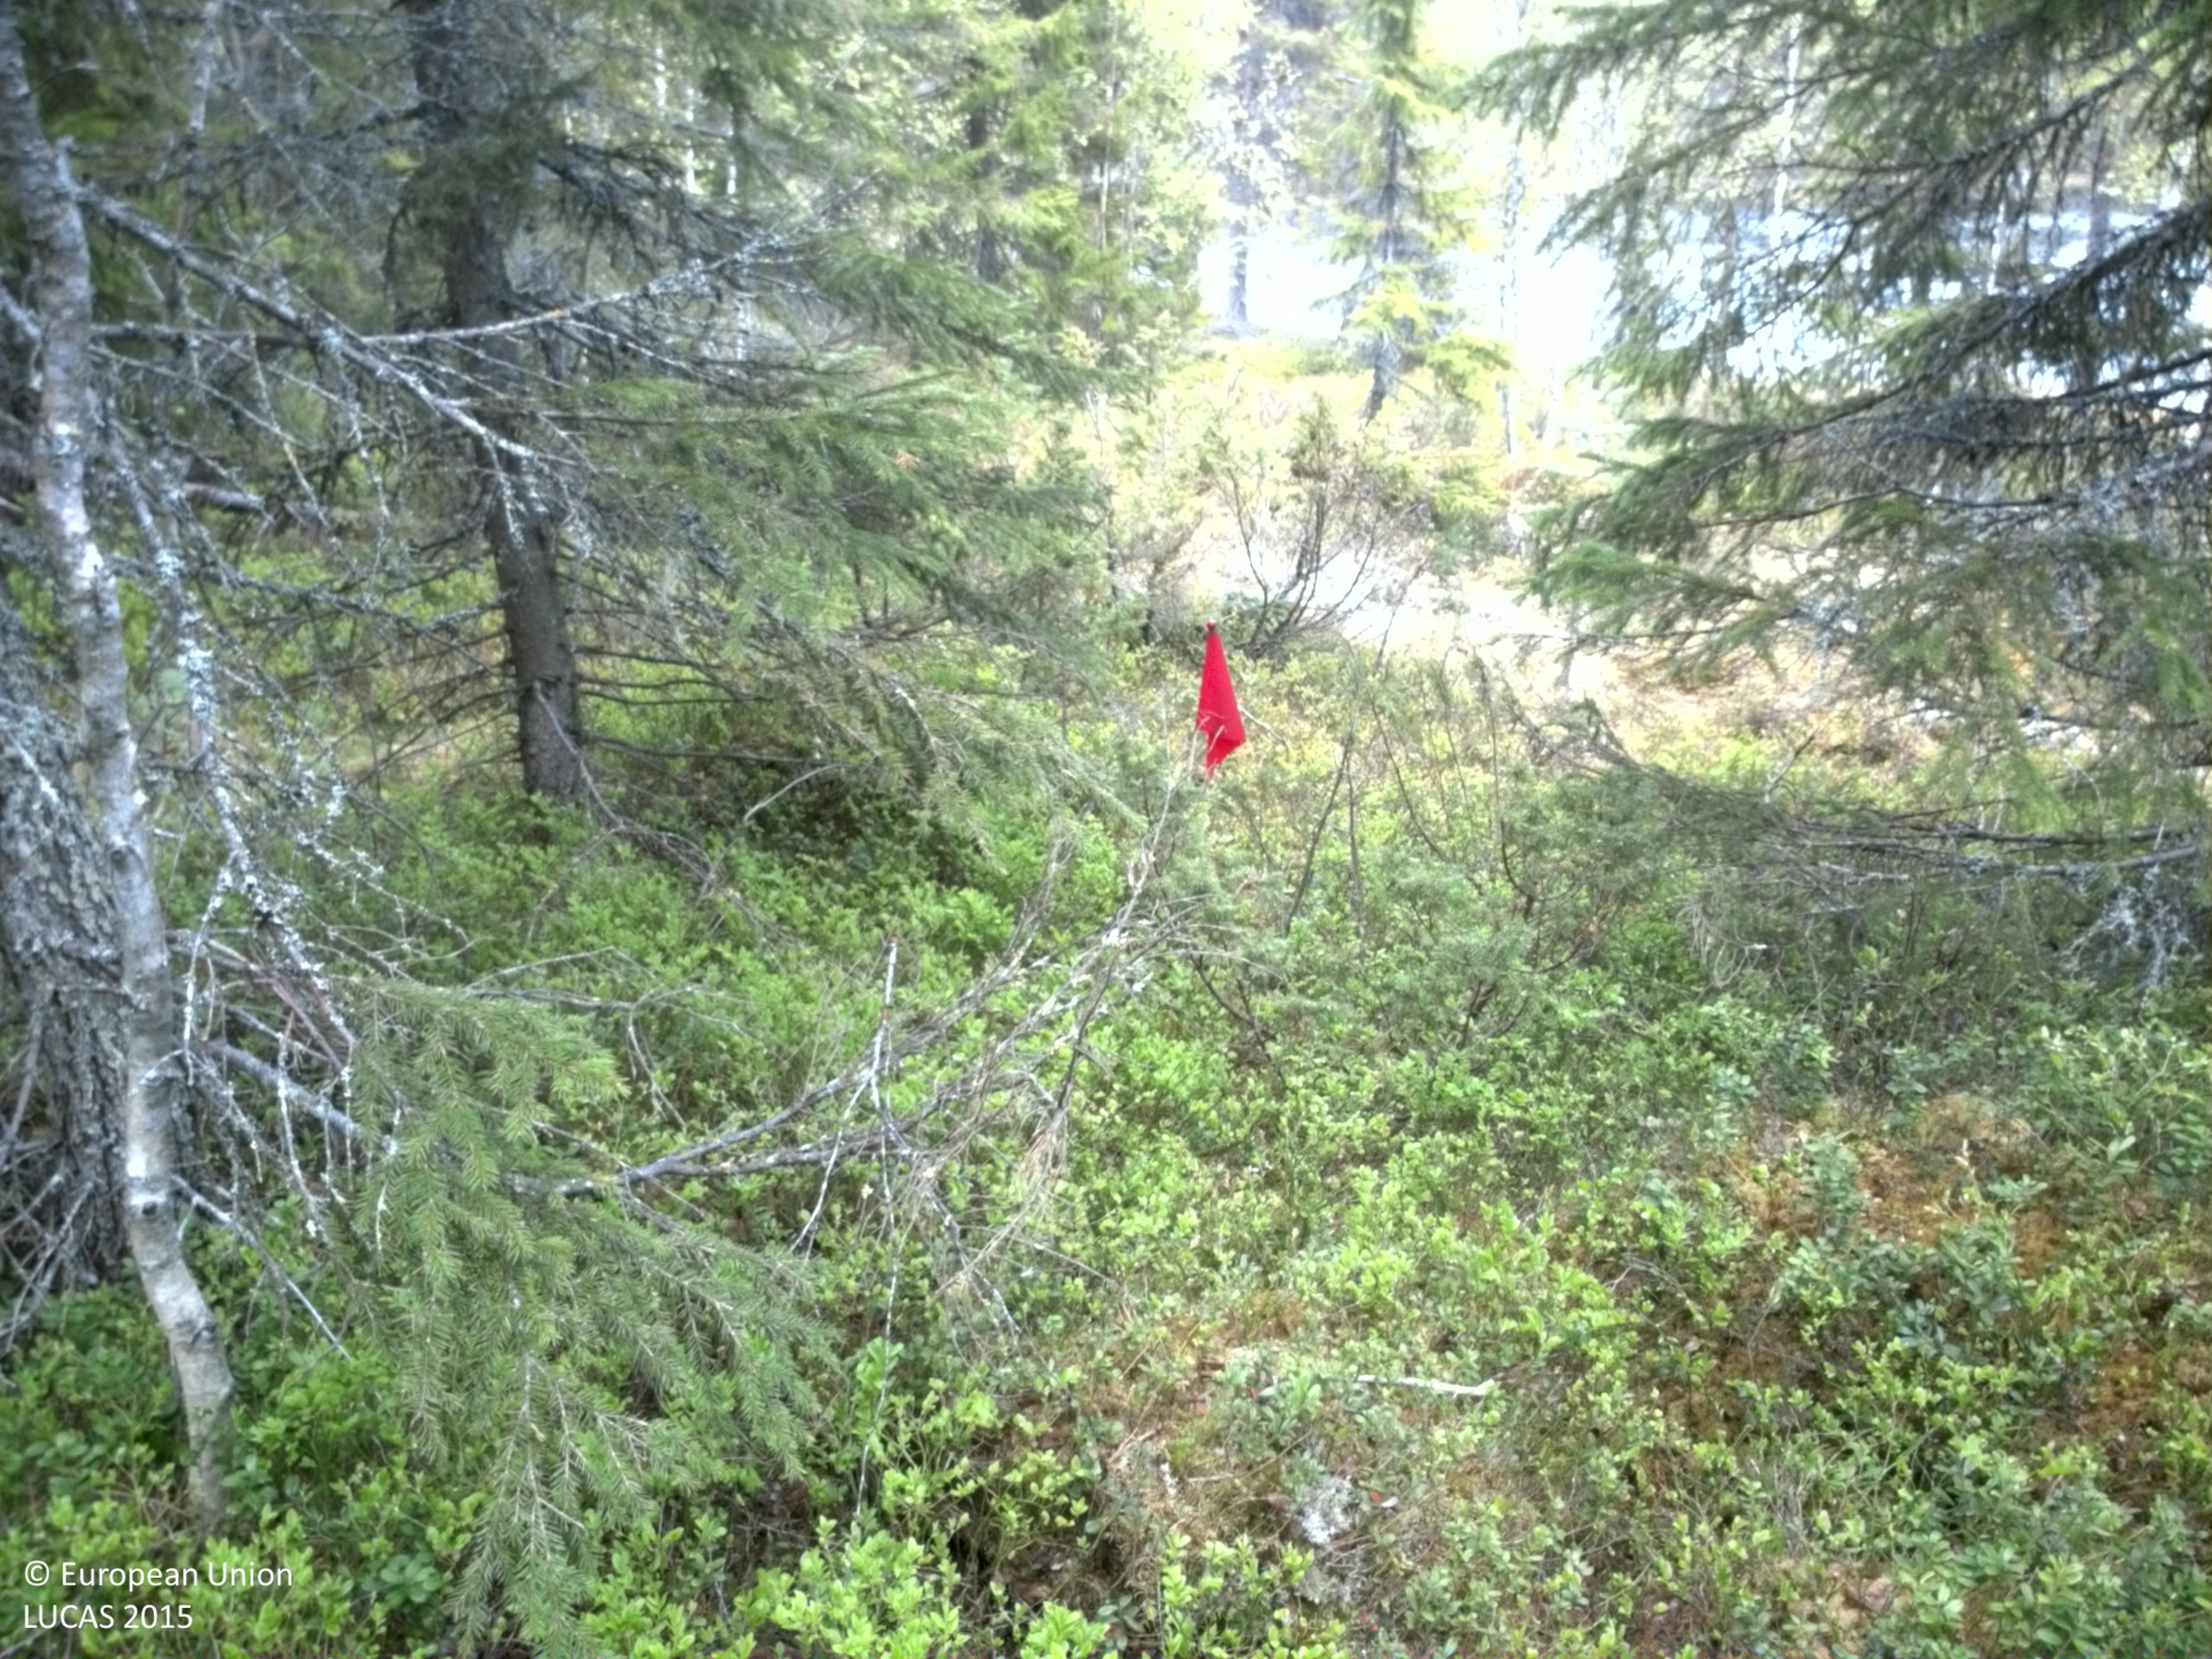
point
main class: Woodland
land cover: Spruce dominated mixed woodland
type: boreal forest
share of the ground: > 75 %
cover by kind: coniferous forest trees 60 %, broadleaved forest trees 20 %, shrubs 10 %, lichens and mosses 10 %
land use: Forestry
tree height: > 5 m
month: June
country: SE
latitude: 62.9432
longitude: 17.2879
